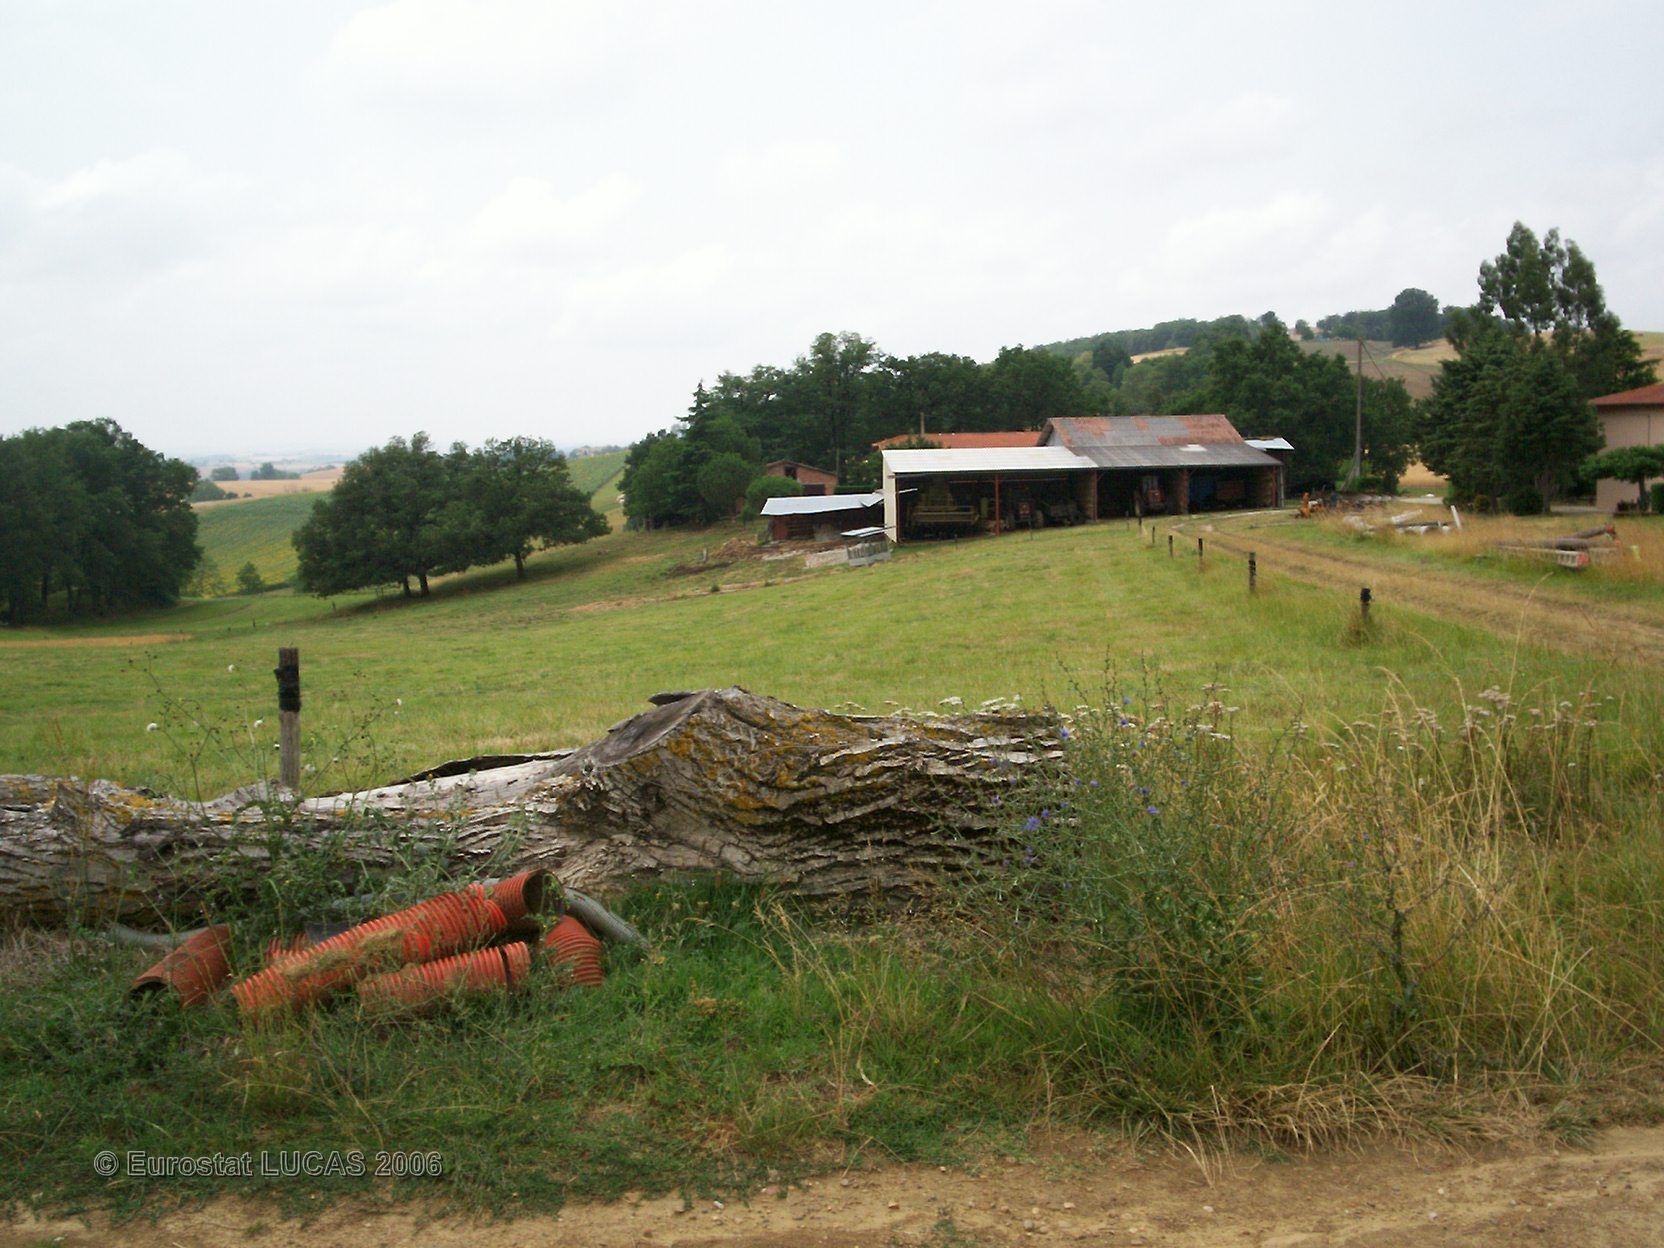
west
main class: Cropland
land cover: Sunflower
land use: Agriculture (excluding fallow land and kitchen gardens)
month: June
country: FR
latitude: 43.7788
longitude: 1.0163
